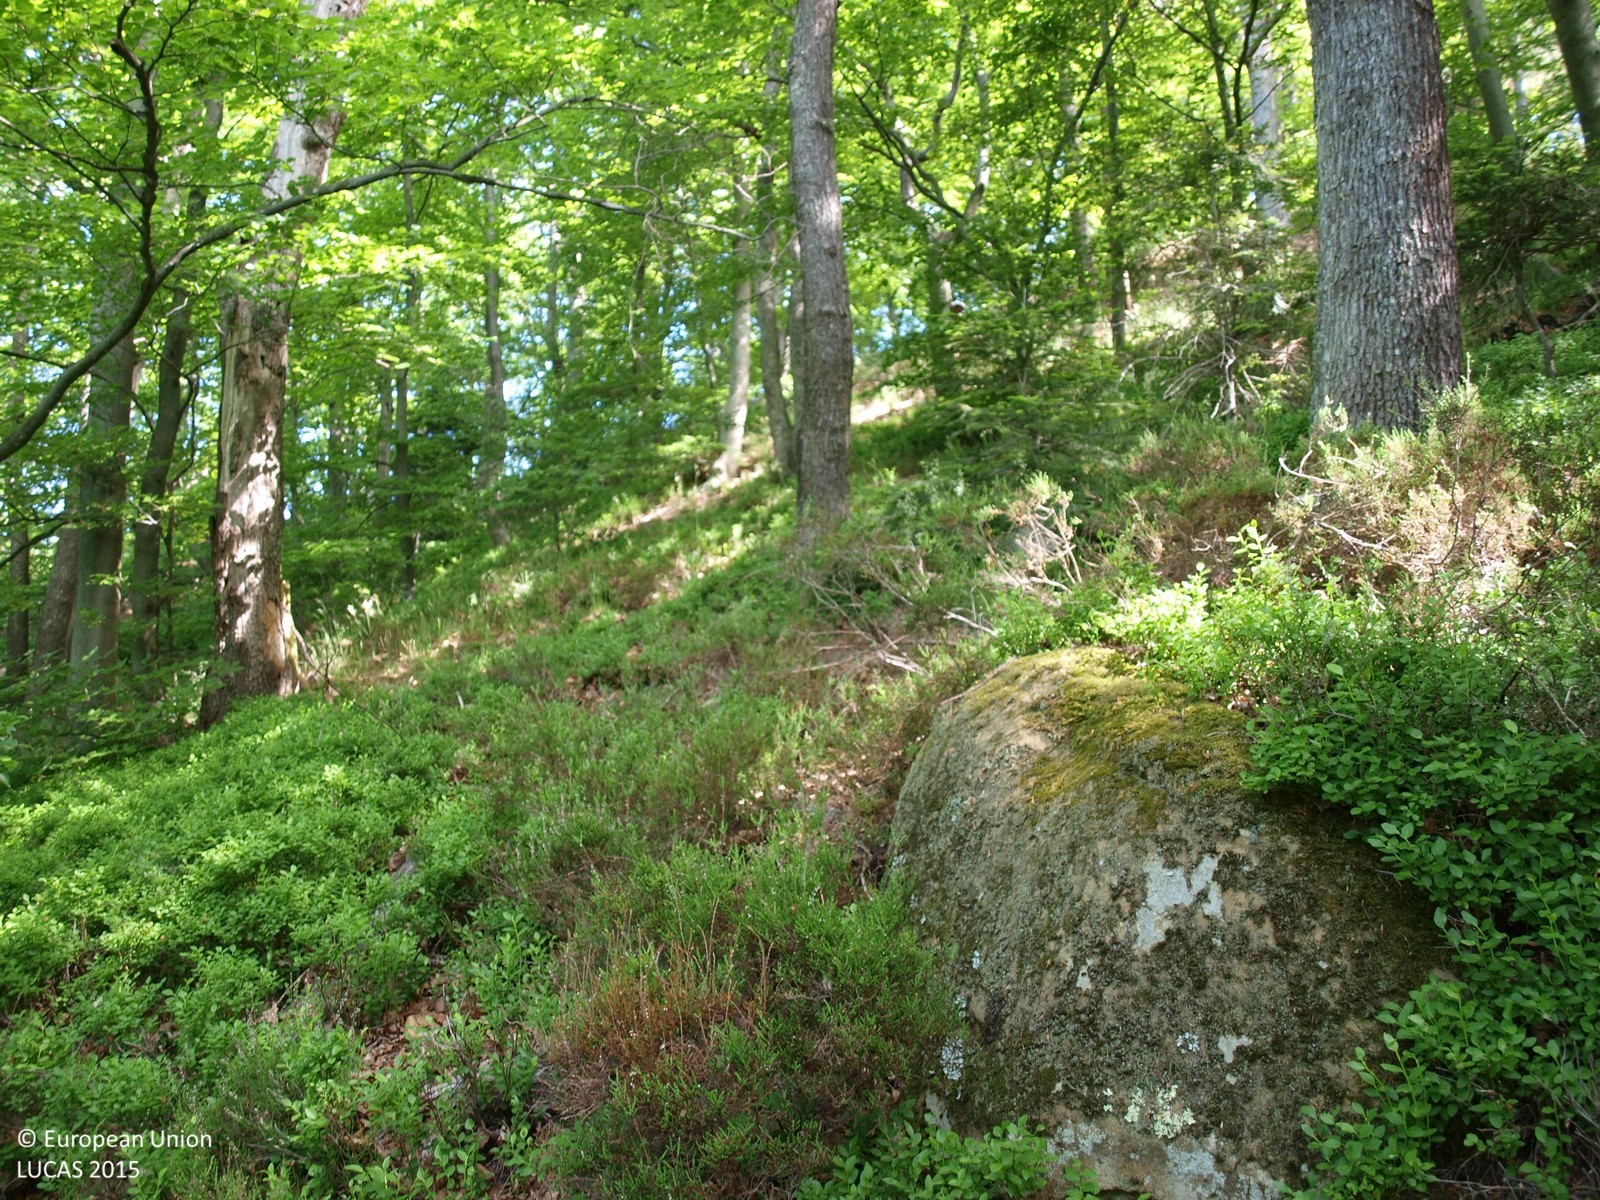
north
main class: Woodland
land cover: Broadleaved woodland
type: mesophytic deciduous forest
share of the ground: > 75 %
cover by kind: broadleaved forest trees 100 %
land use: Forestry
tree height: > 5 m
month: May
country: HR
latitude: 46.2605
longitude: 15.9018
